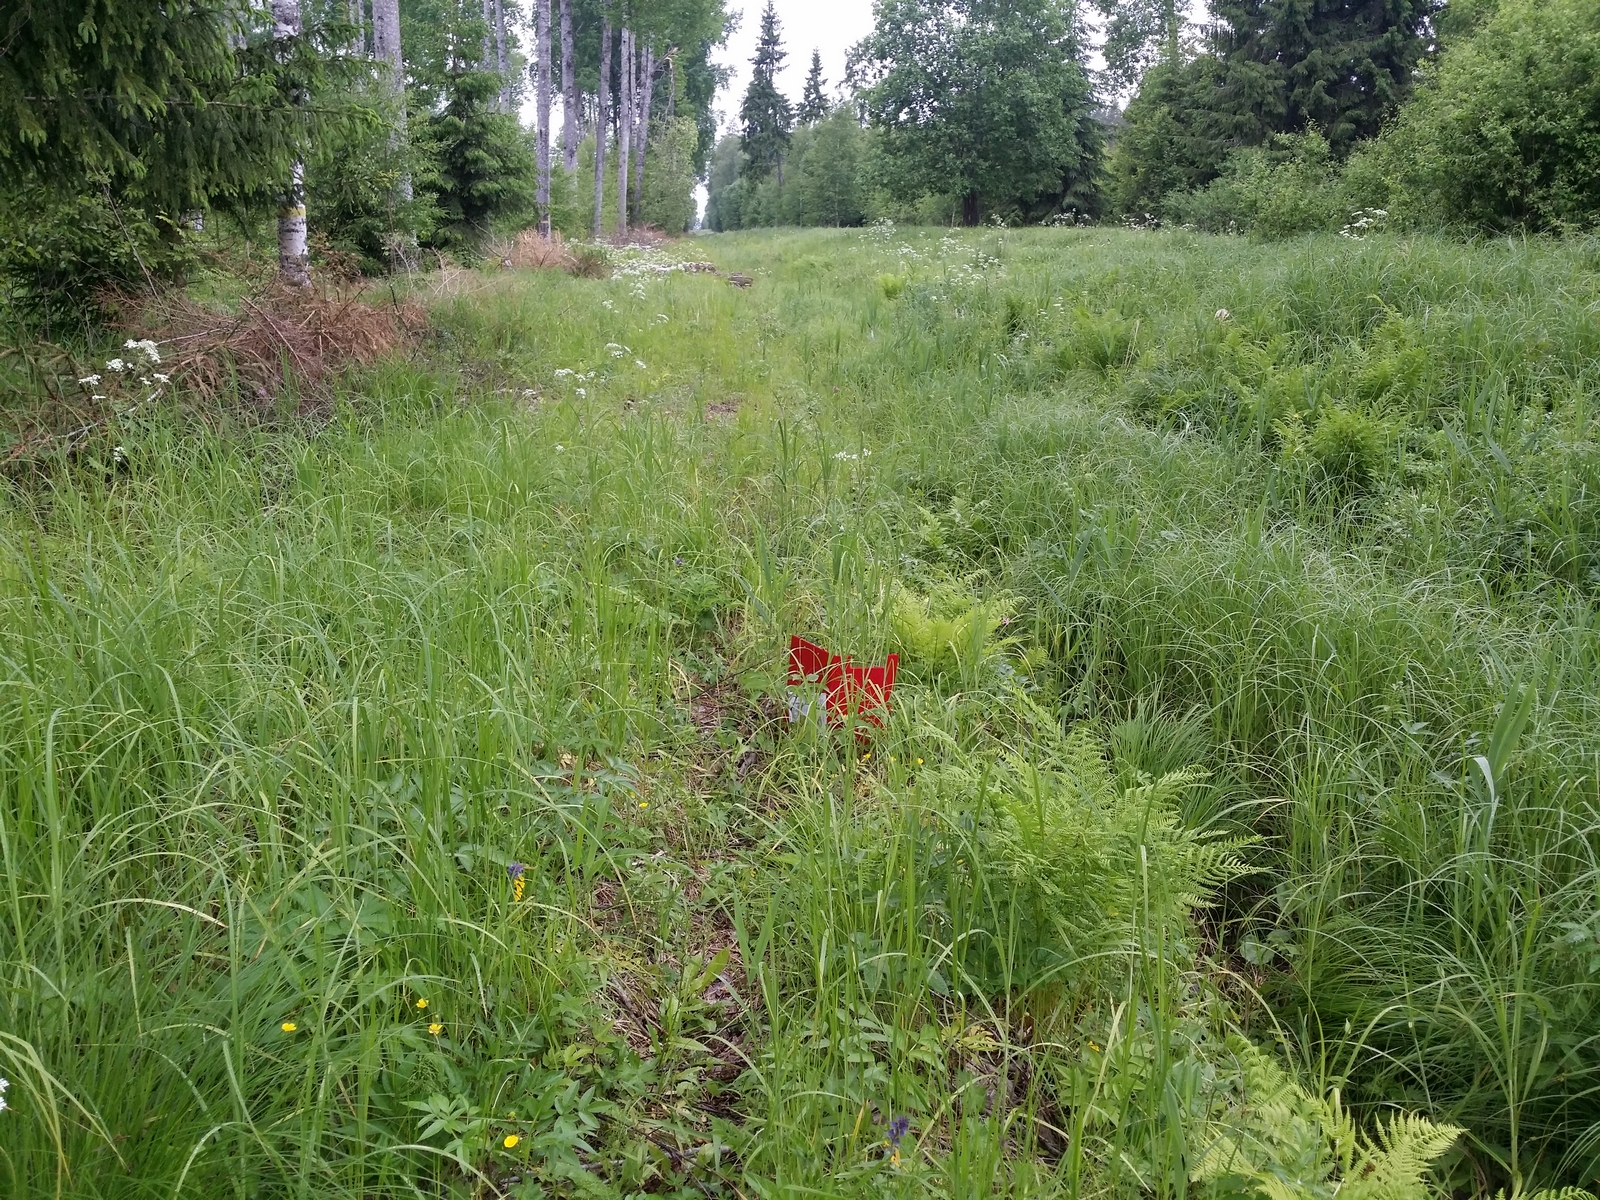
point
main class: Grassland
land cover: Spontaneously vegetated surfaces
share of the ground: > 75 %
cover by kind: herbaceous plants 95 %, shrubs 5 %
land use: Forestry
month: June
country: LV
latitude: 57.5175
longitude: 26.5211
